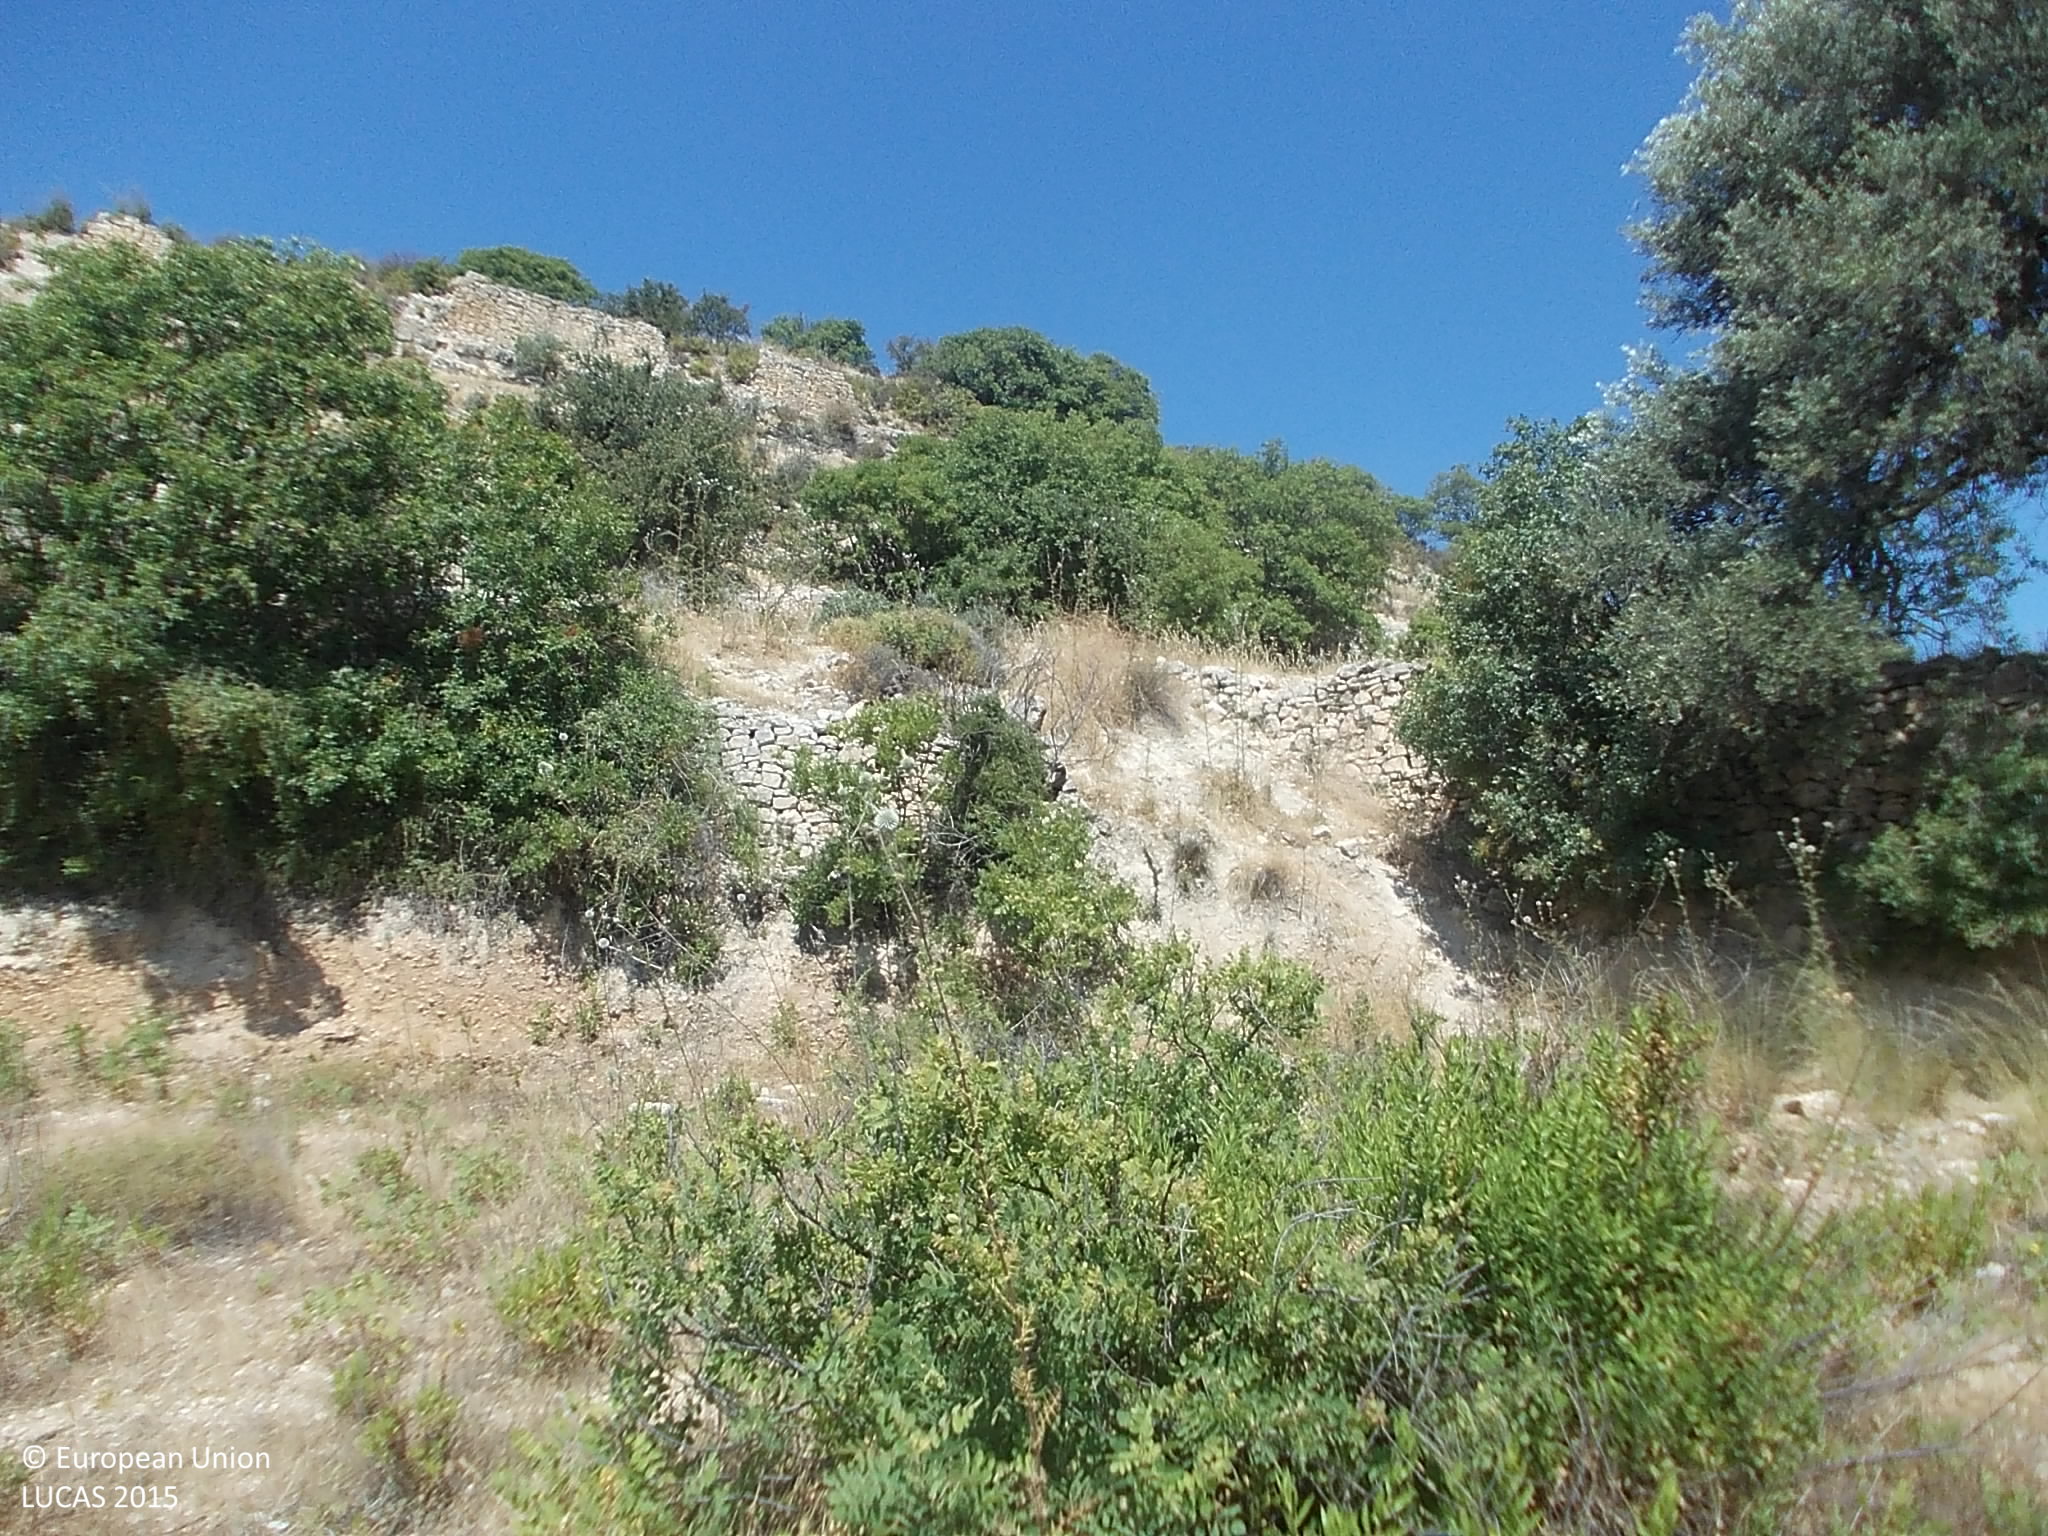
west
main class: Shrubland
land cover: Shrubland with sparse tree cover
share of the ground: 50 - 75 %
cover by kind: shrubs 65 %, unconsolidated bare surface 20 %, herbaceous plants 10 %, broadleaved forest trees 5 %
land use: Semi-natural and natural areas not in use
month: July
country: CY
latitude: 34.7918
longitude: 32.8614
